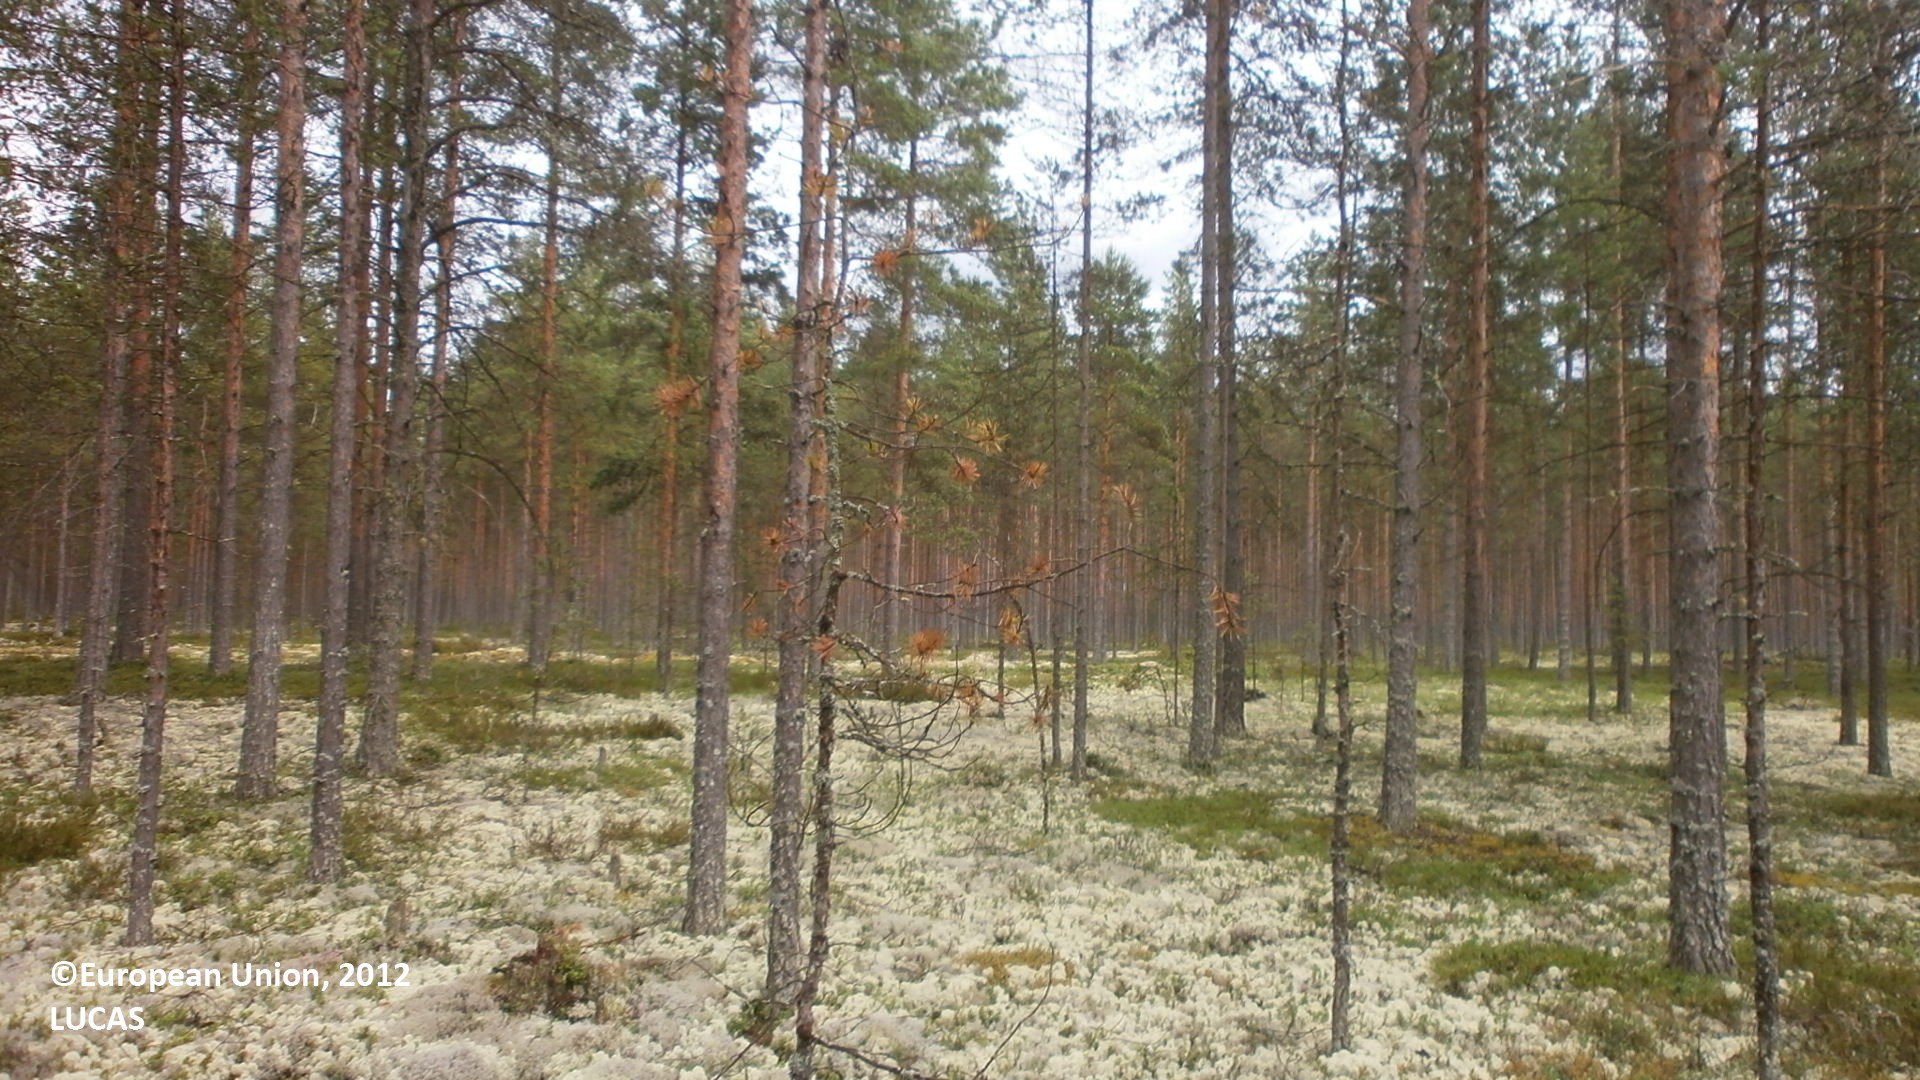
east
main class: Woodland
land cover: Pine dominated coniferous woodland
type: boreal forest
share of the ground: 50 - 75 %
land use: Forestry
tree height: > 5 m
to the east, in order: Pine dominated coniferous woodland; Lichens and moss; Tracks; Pine dominated coniferous woodland; Tracks; Pine dominated coniferous woodland; Tracks; Pine dominated coniferous woodland
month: July
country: FI
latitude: 64.1368
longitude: 23.8479
